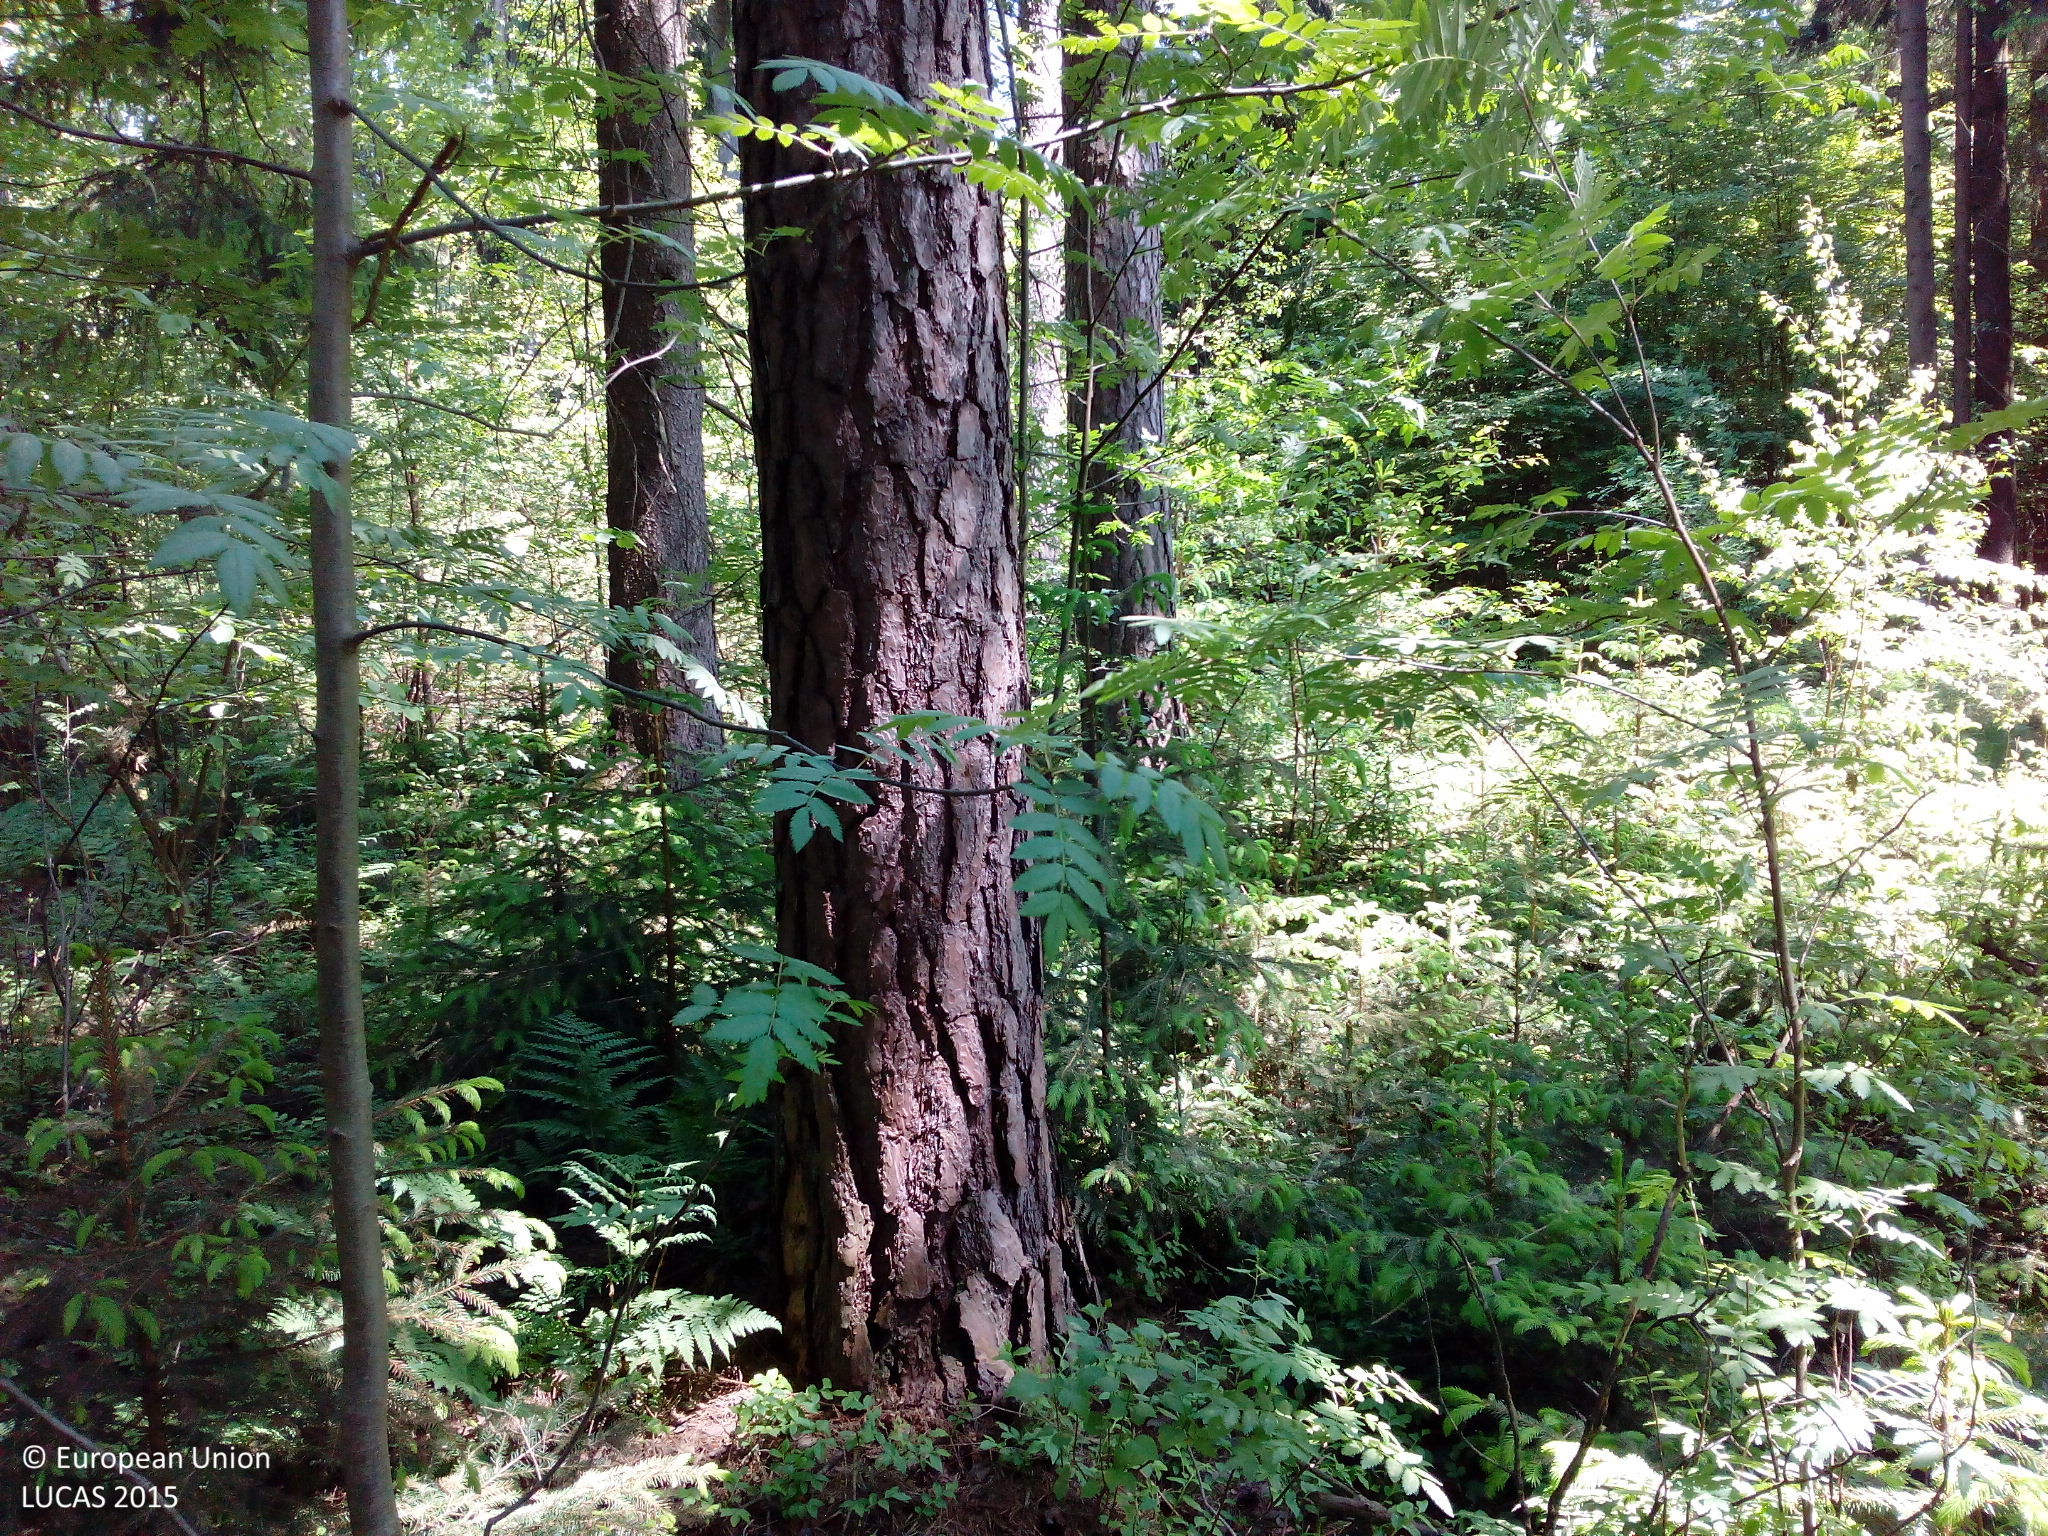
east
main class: Woodland
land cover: Other coniferous woodland
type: hemiboreal forest and nemoral coniferous forest and mixed broadleaved-coniferous forest
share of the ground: > 75 %
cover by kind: coniferous forest trees 75 %, herbaceous plants 10 %, lichens and mosses 10 %, broadleaved forest trees 5 %
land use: Forestry
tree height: > 5 m
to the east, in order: Other coniferous woodland; Grassland with sparse tree/shrub cover; Spruce dominated coniferous woodland; Tracks; Spruce dominated coniferous woodland; Broadleaved woodland; Grass margins; Tracks
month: May
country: DE
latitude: 49.1311
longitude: 11.4933
